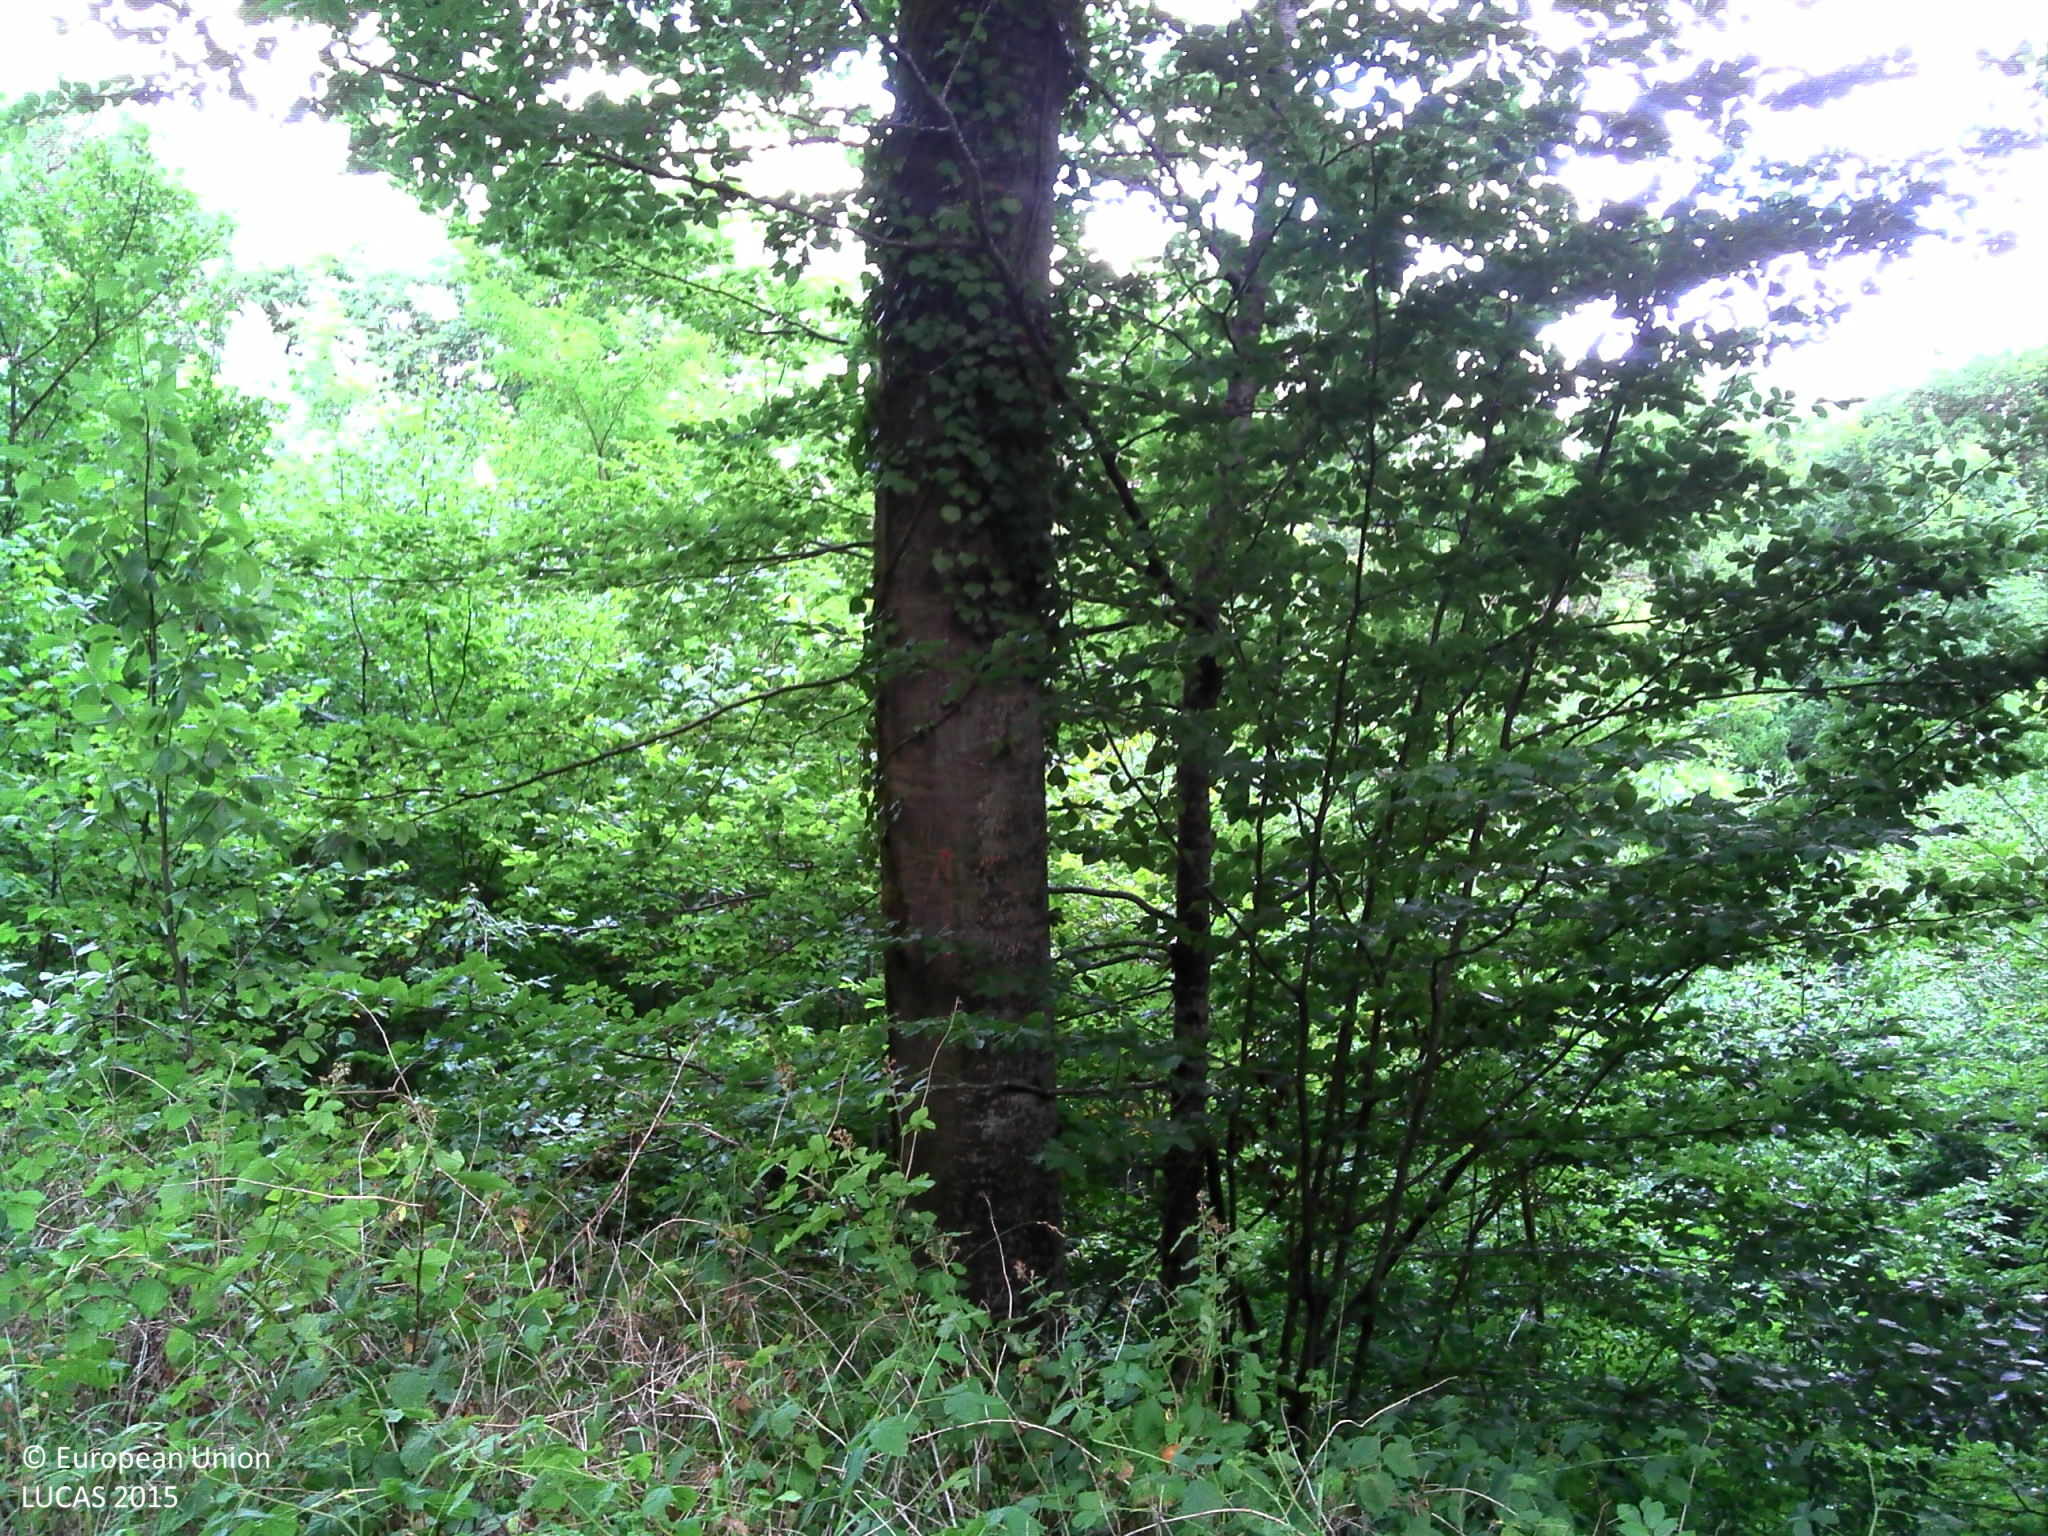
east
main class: Woodland
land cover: Broadleaved woodland
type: beech forest
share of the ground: > 75 %
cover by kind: broadleaved forest trees 80 %, herbaceous plants 10 %, lichens and mosses 10 %
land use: Forestry
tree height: > 5 m
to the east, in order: Broadleaved woodland; Tracks; Broadleaved woodland
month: July
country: FR
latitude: 47.6703
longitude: 5.2456
